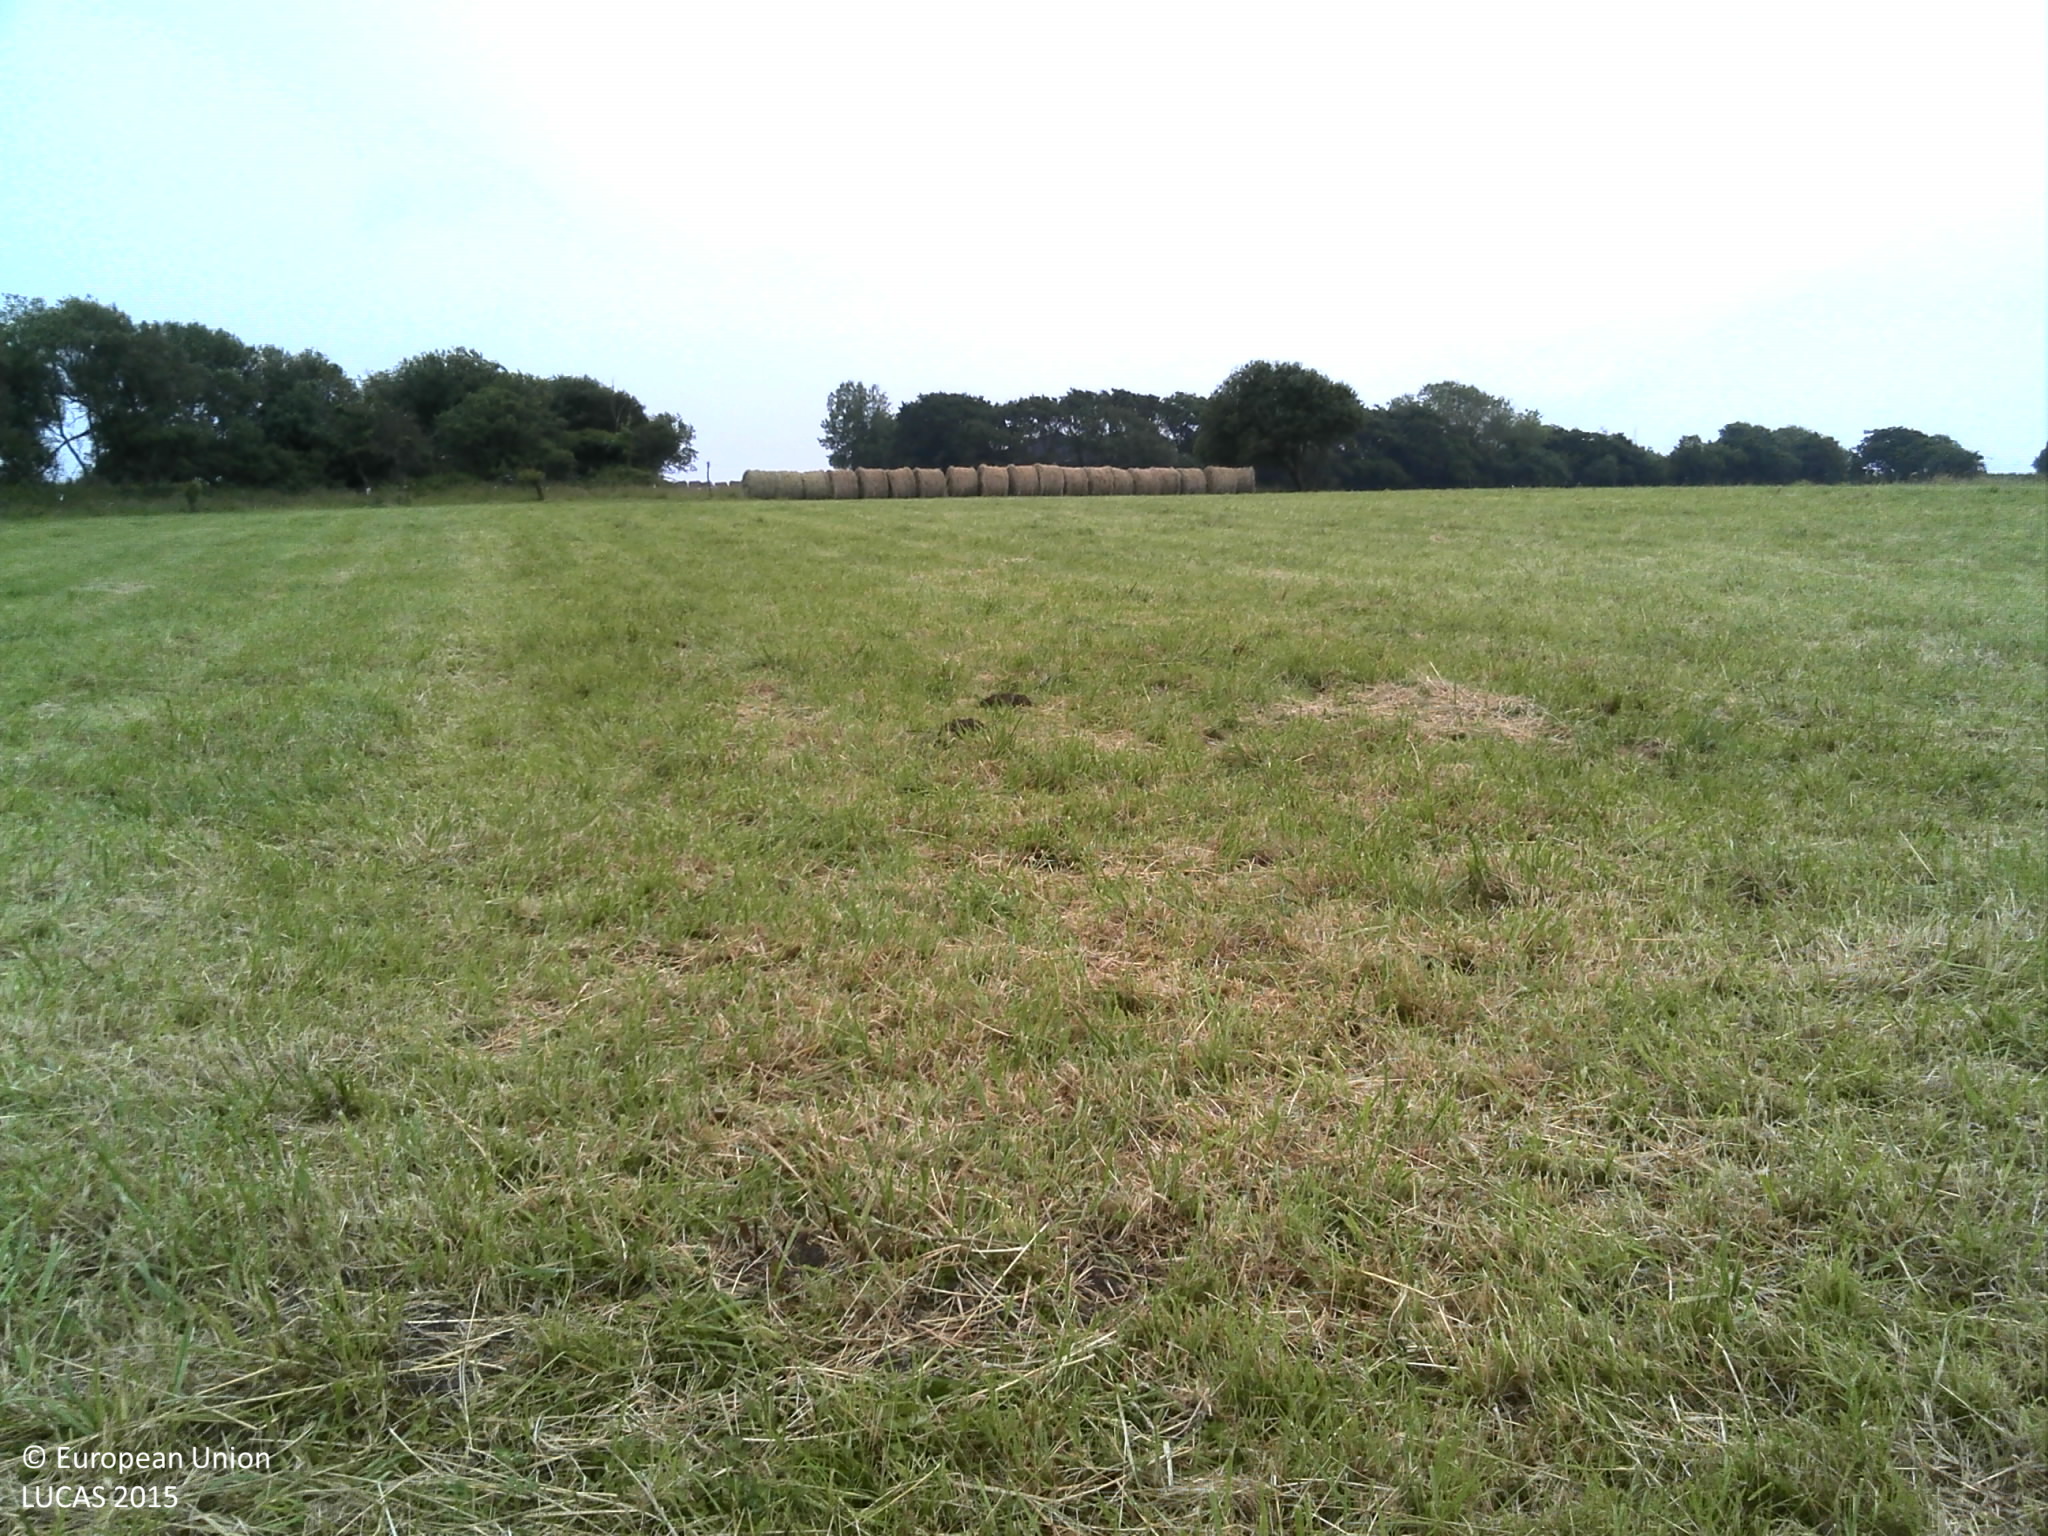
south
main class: Grassland
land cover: Grassland without tree/shrub cover
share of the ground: > 75 %
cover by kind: herbaceous plants 100 %
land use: Agriculture (excluding fallow land and kitchen gardens)
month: June
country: FR
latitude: 47.9506
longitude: -4.3807
